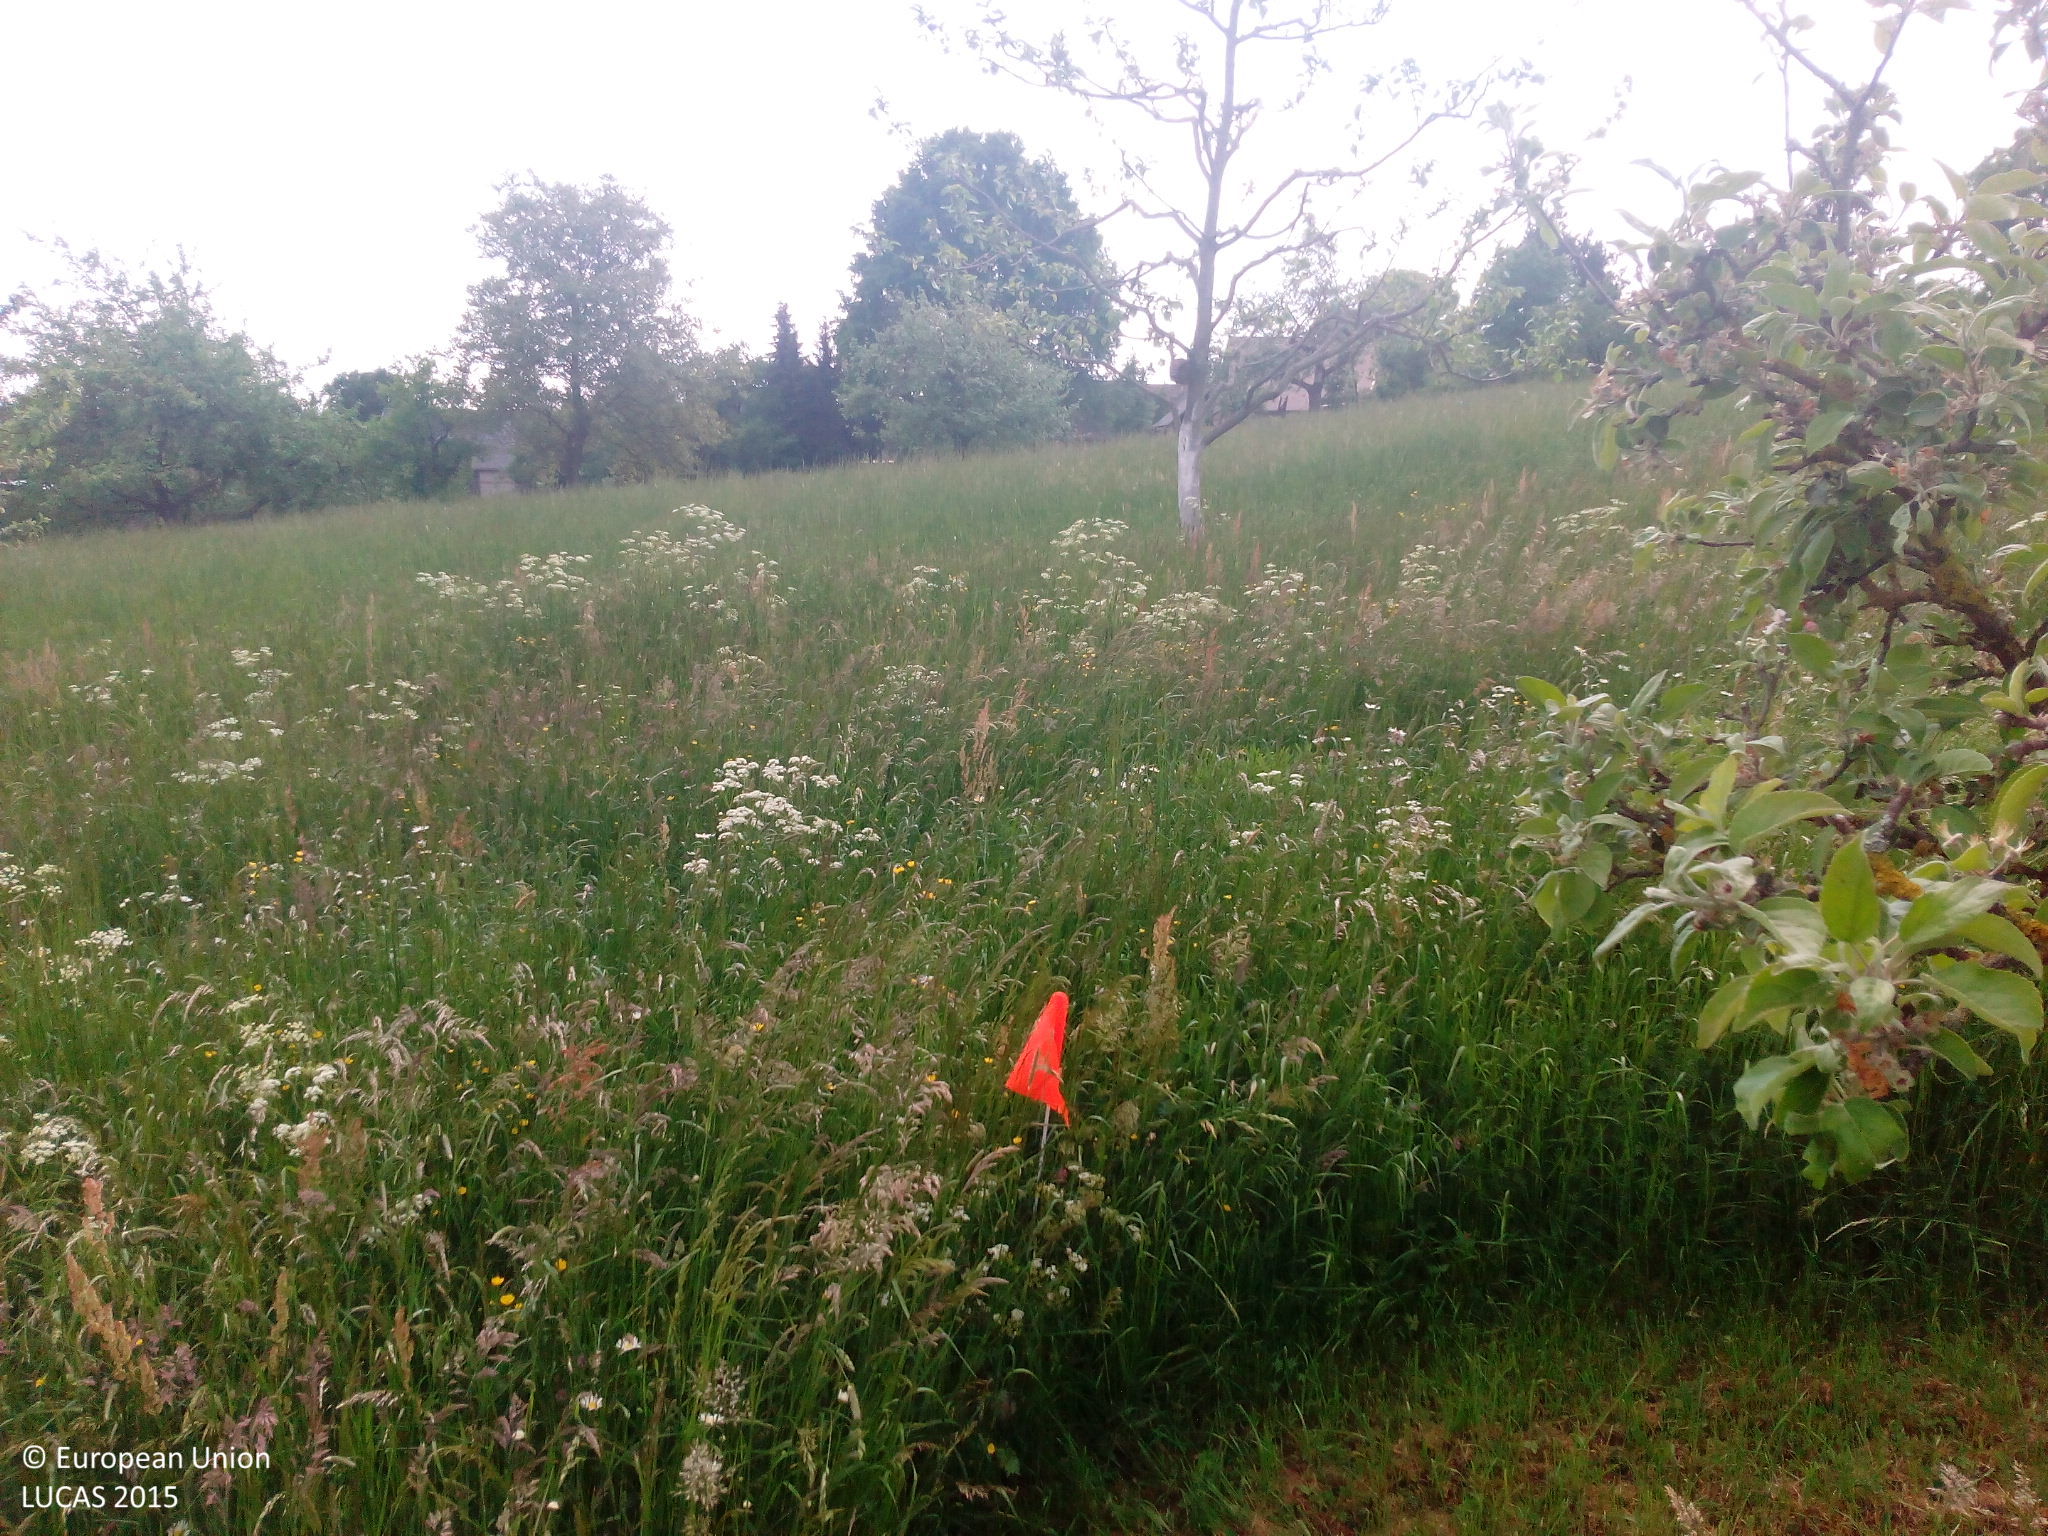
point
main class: Cropland
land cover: Apple fruit
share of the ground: 10 - 25 %
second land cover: Grassland without tree/shrub cover
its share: > 75 %
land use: Agriculture (excluding fallow land and kitchen gardens)
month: May
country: DE
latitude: 50.1804
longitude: 10.9380
